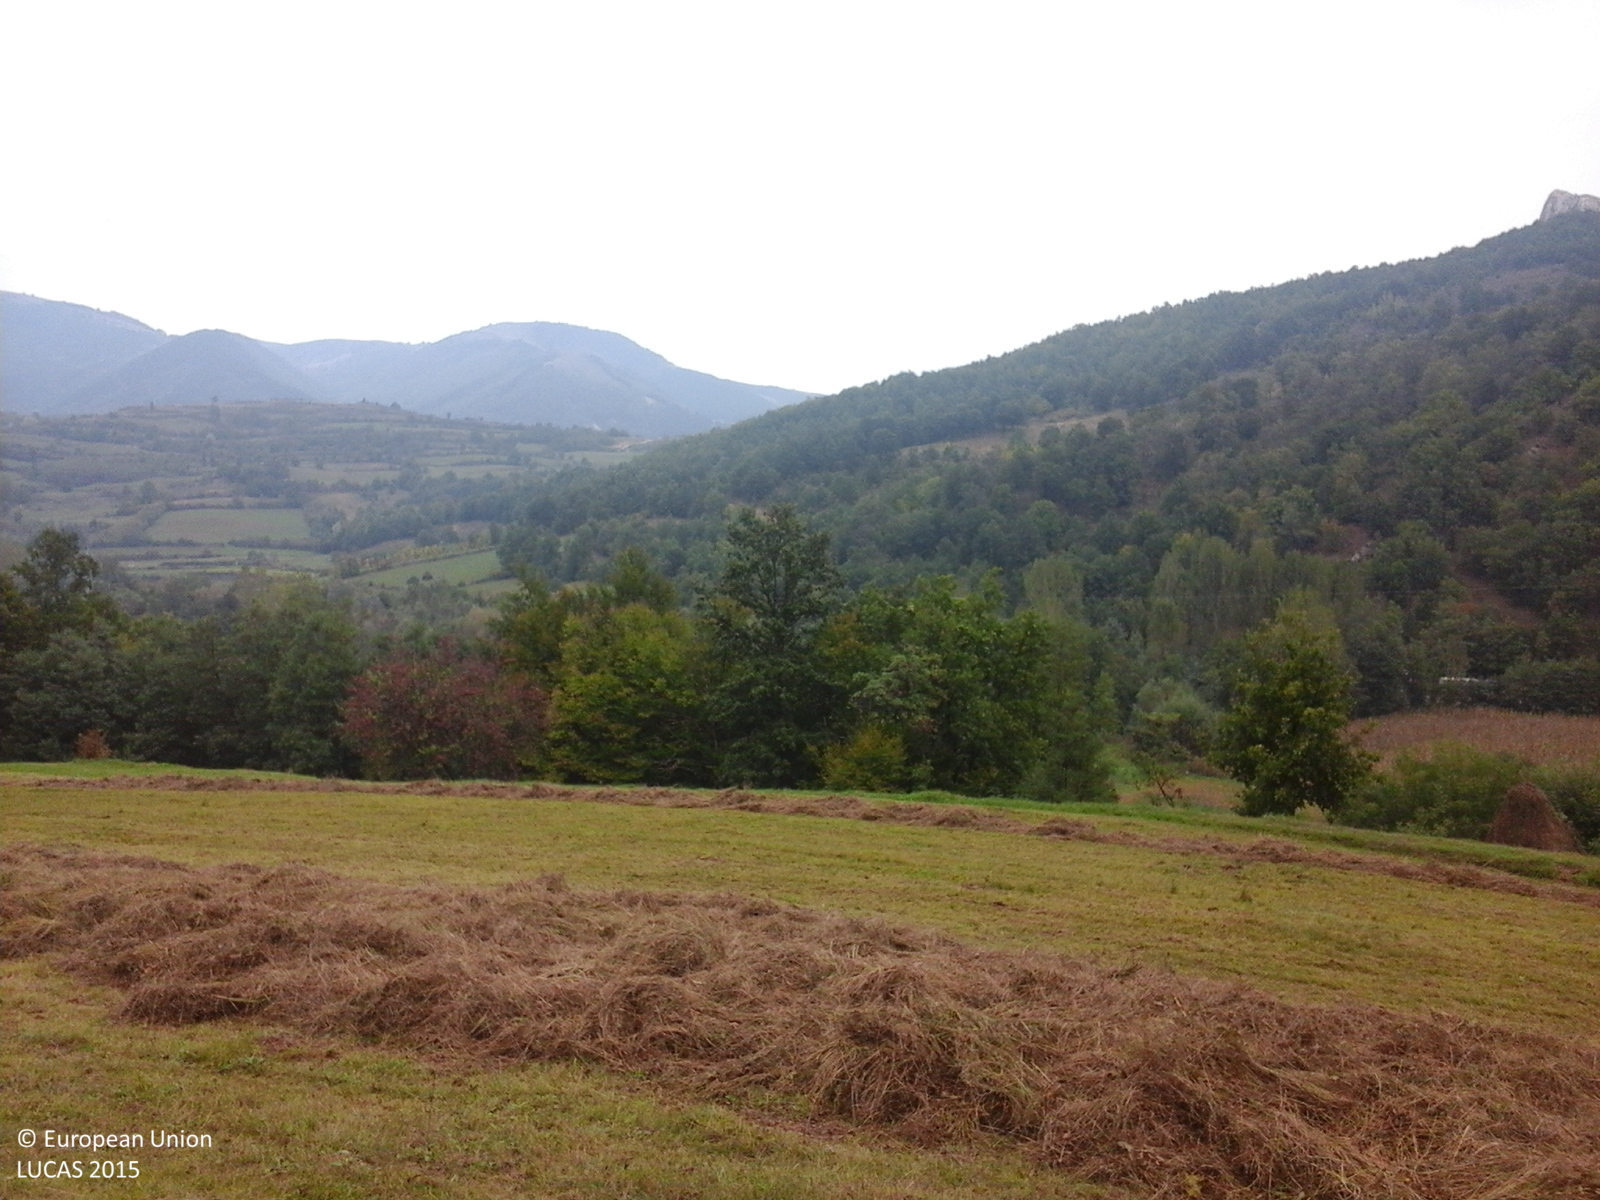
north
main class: Grassland
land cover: Grassland without tree/shrub cover
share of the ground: > 75 %
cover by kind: herbaceous plants 100 %
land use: Agriculture (excluding fallow land and kitchen gardens)
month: October
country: RO
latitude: 46.0990
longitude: 23.4526
